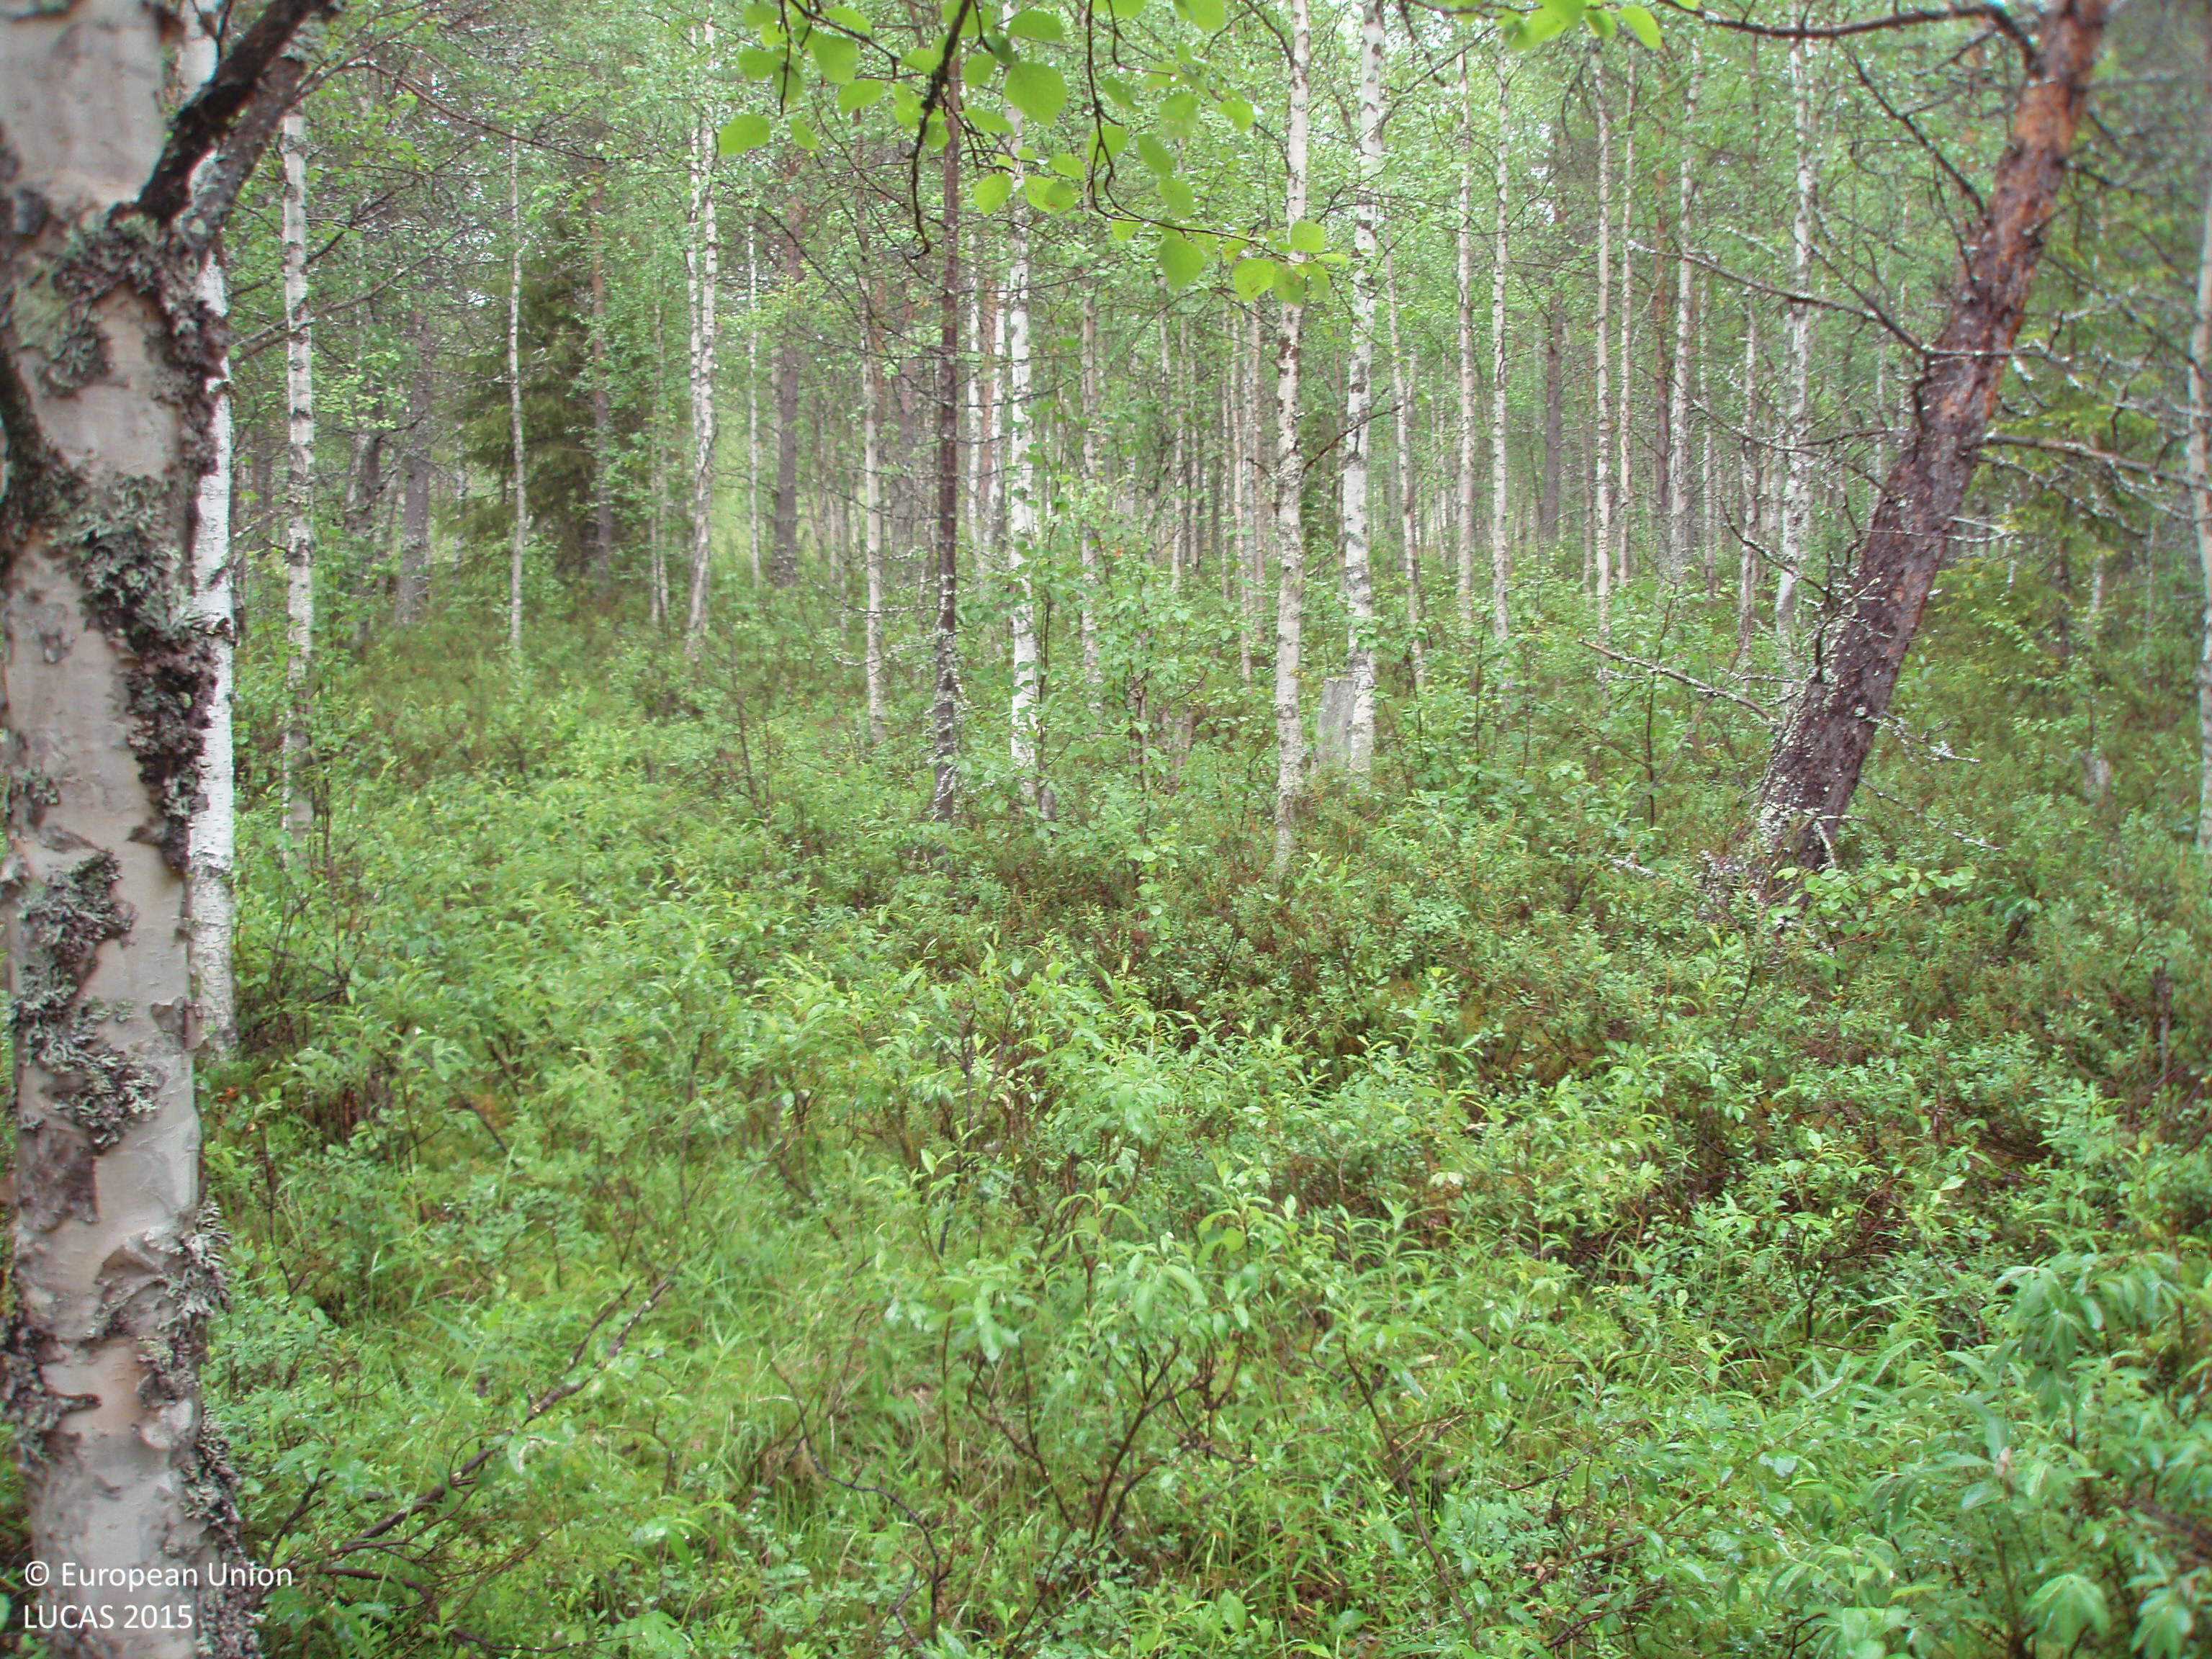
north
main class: Woodland
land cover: Pine dominated mixed woodland
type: boreal forest
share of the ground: > 75 %
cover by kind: broadleaved forest trees 55 %, coniferous forest trees 25 %, shrubs 20 %
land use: Forestry
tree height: > 5 m
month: July
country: FI
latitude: 66.7239
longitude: 27.9255
